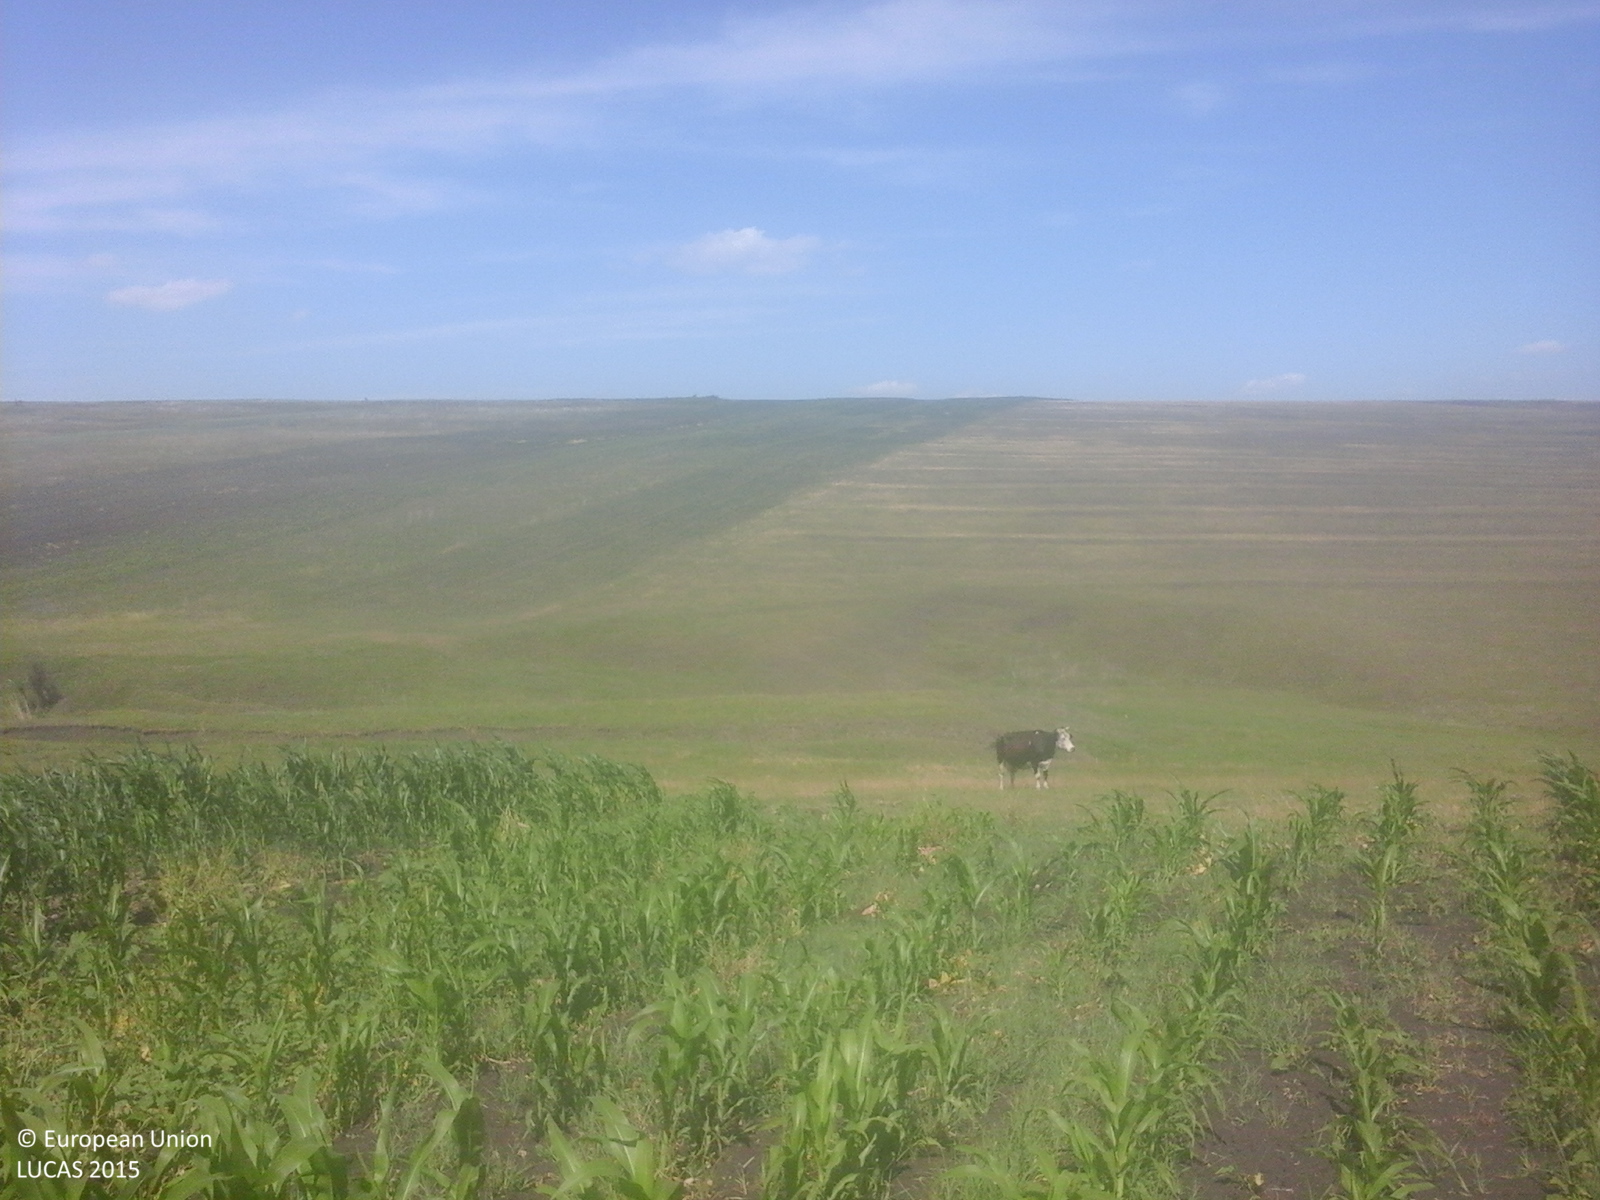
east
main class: Cropland
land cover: Maize
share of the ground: 50 - 75 %
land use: Agriculture (excluding fallow land and kitchen gardens)
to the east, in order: Maize; Grassland without tree/shrub cover
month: June
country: RO
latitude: 47.9915
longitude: 26.8940
